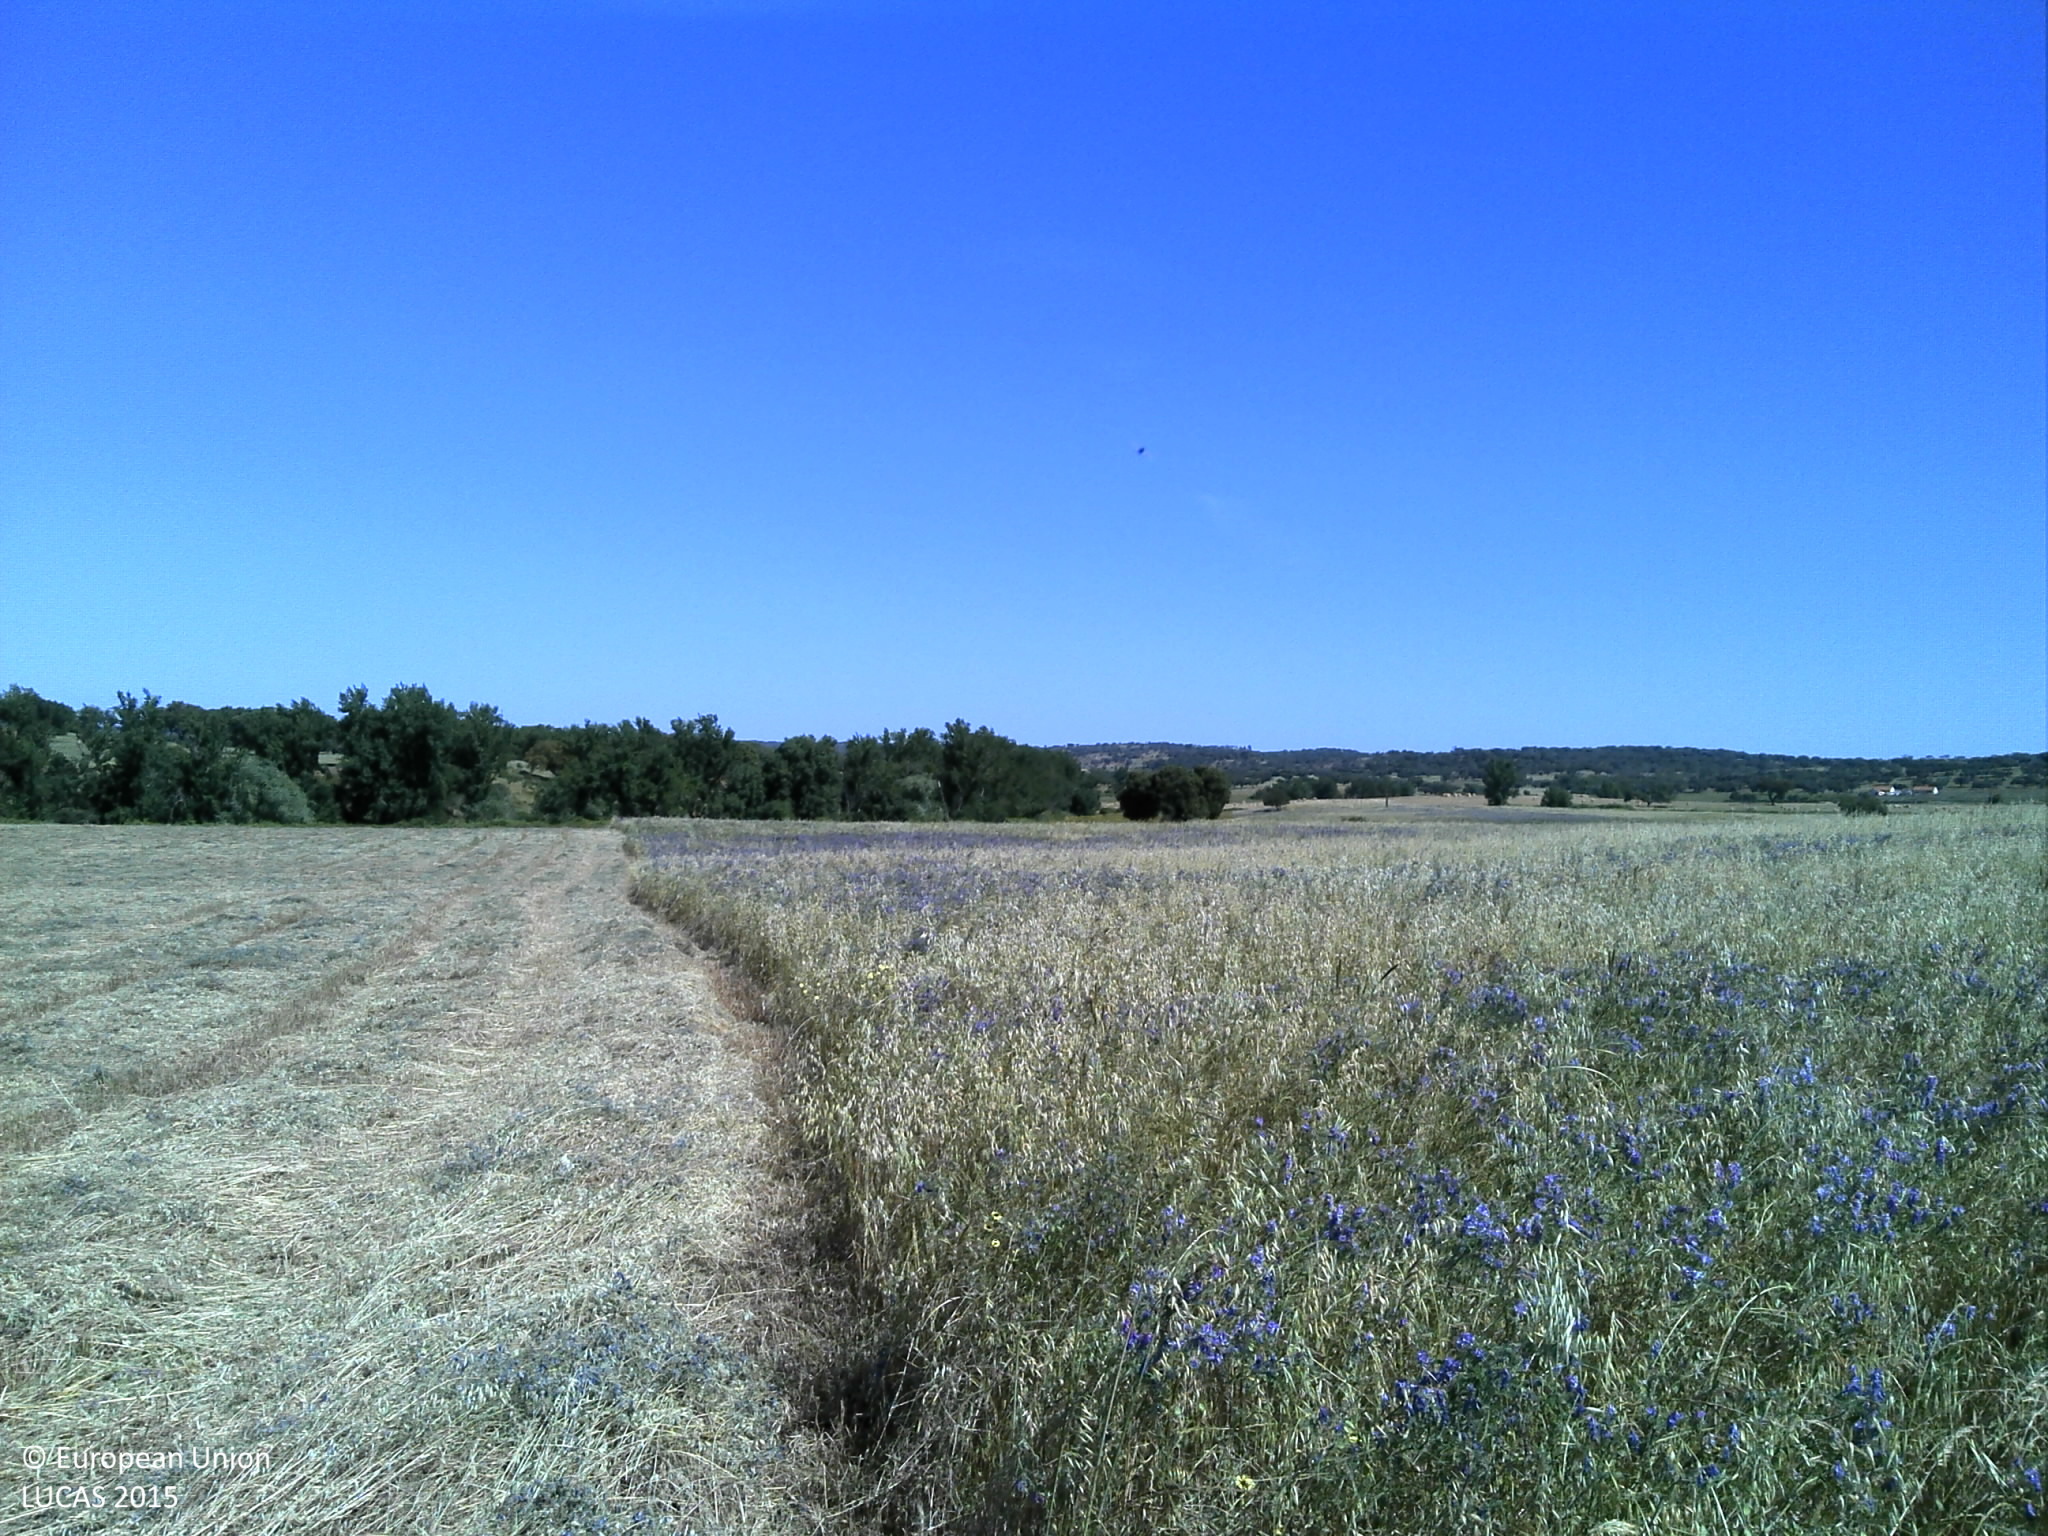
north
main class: Cropland
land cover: Temporary grasslands
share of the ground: > 75 %
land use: Agriculture (excluding fallow land and kitchen gardens)
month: May
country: PT
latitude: 39.1717
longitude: -7.8394
